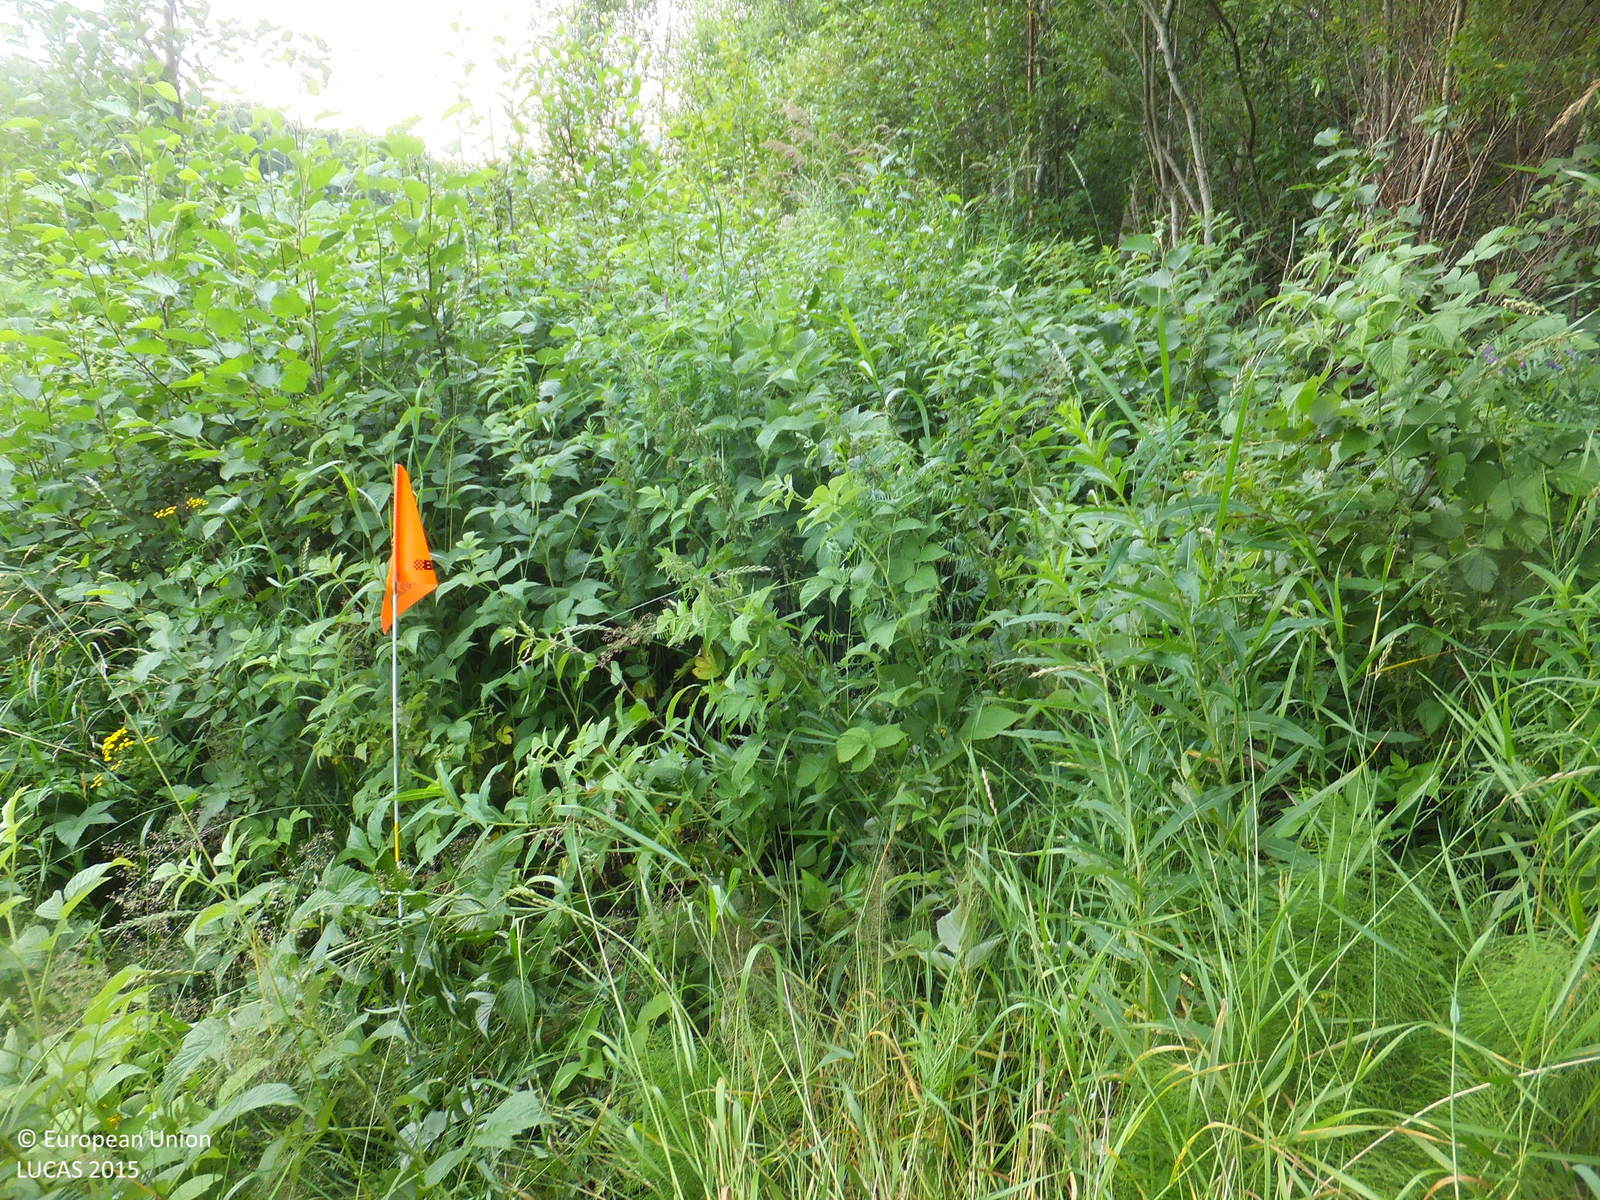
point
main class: Woodland
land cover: Broadleaved woodland
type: boreal forest
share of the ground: > 75 %
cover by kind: broadleaved forest trees 60 %, herbaceous plants 25 %, shrubs 15 %
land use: Forestry
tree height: > 5 m
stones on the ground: < 10 %
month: July
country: FI
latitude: 63.0917
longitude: 21.8669
